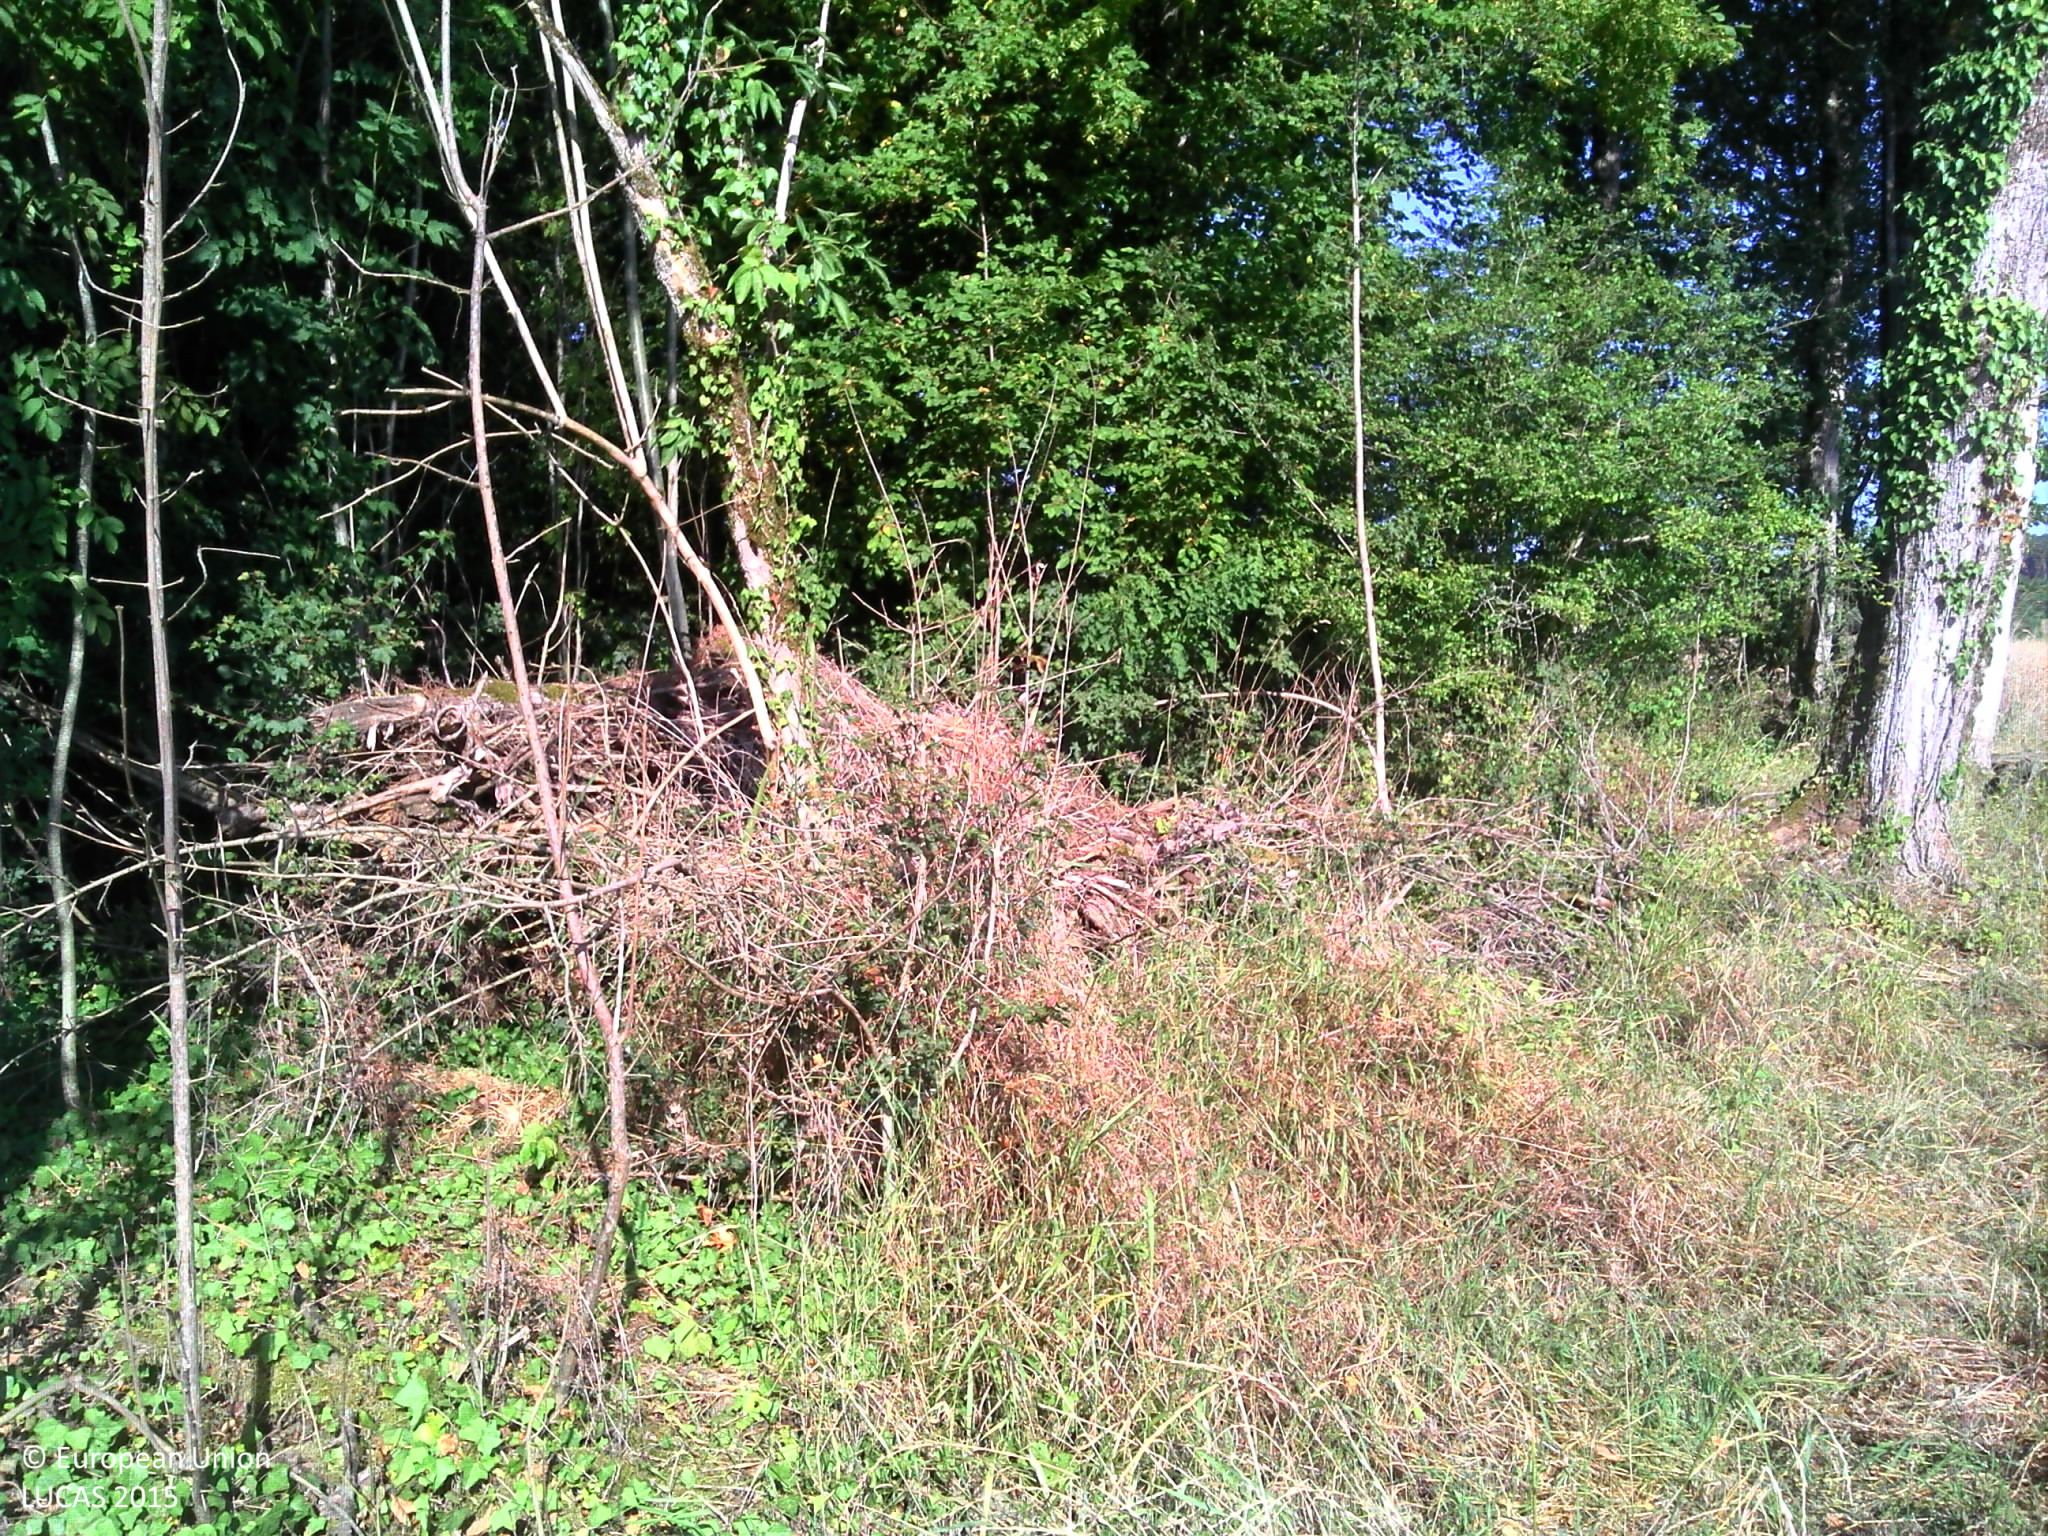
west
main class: Cropland
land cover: Rape and turnip rape
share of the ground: 10 - 25 %
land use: Agriculture (excluding fallow land and kitchen gardens)
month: July
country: FR
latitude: 48.0534
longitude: 4.9410
